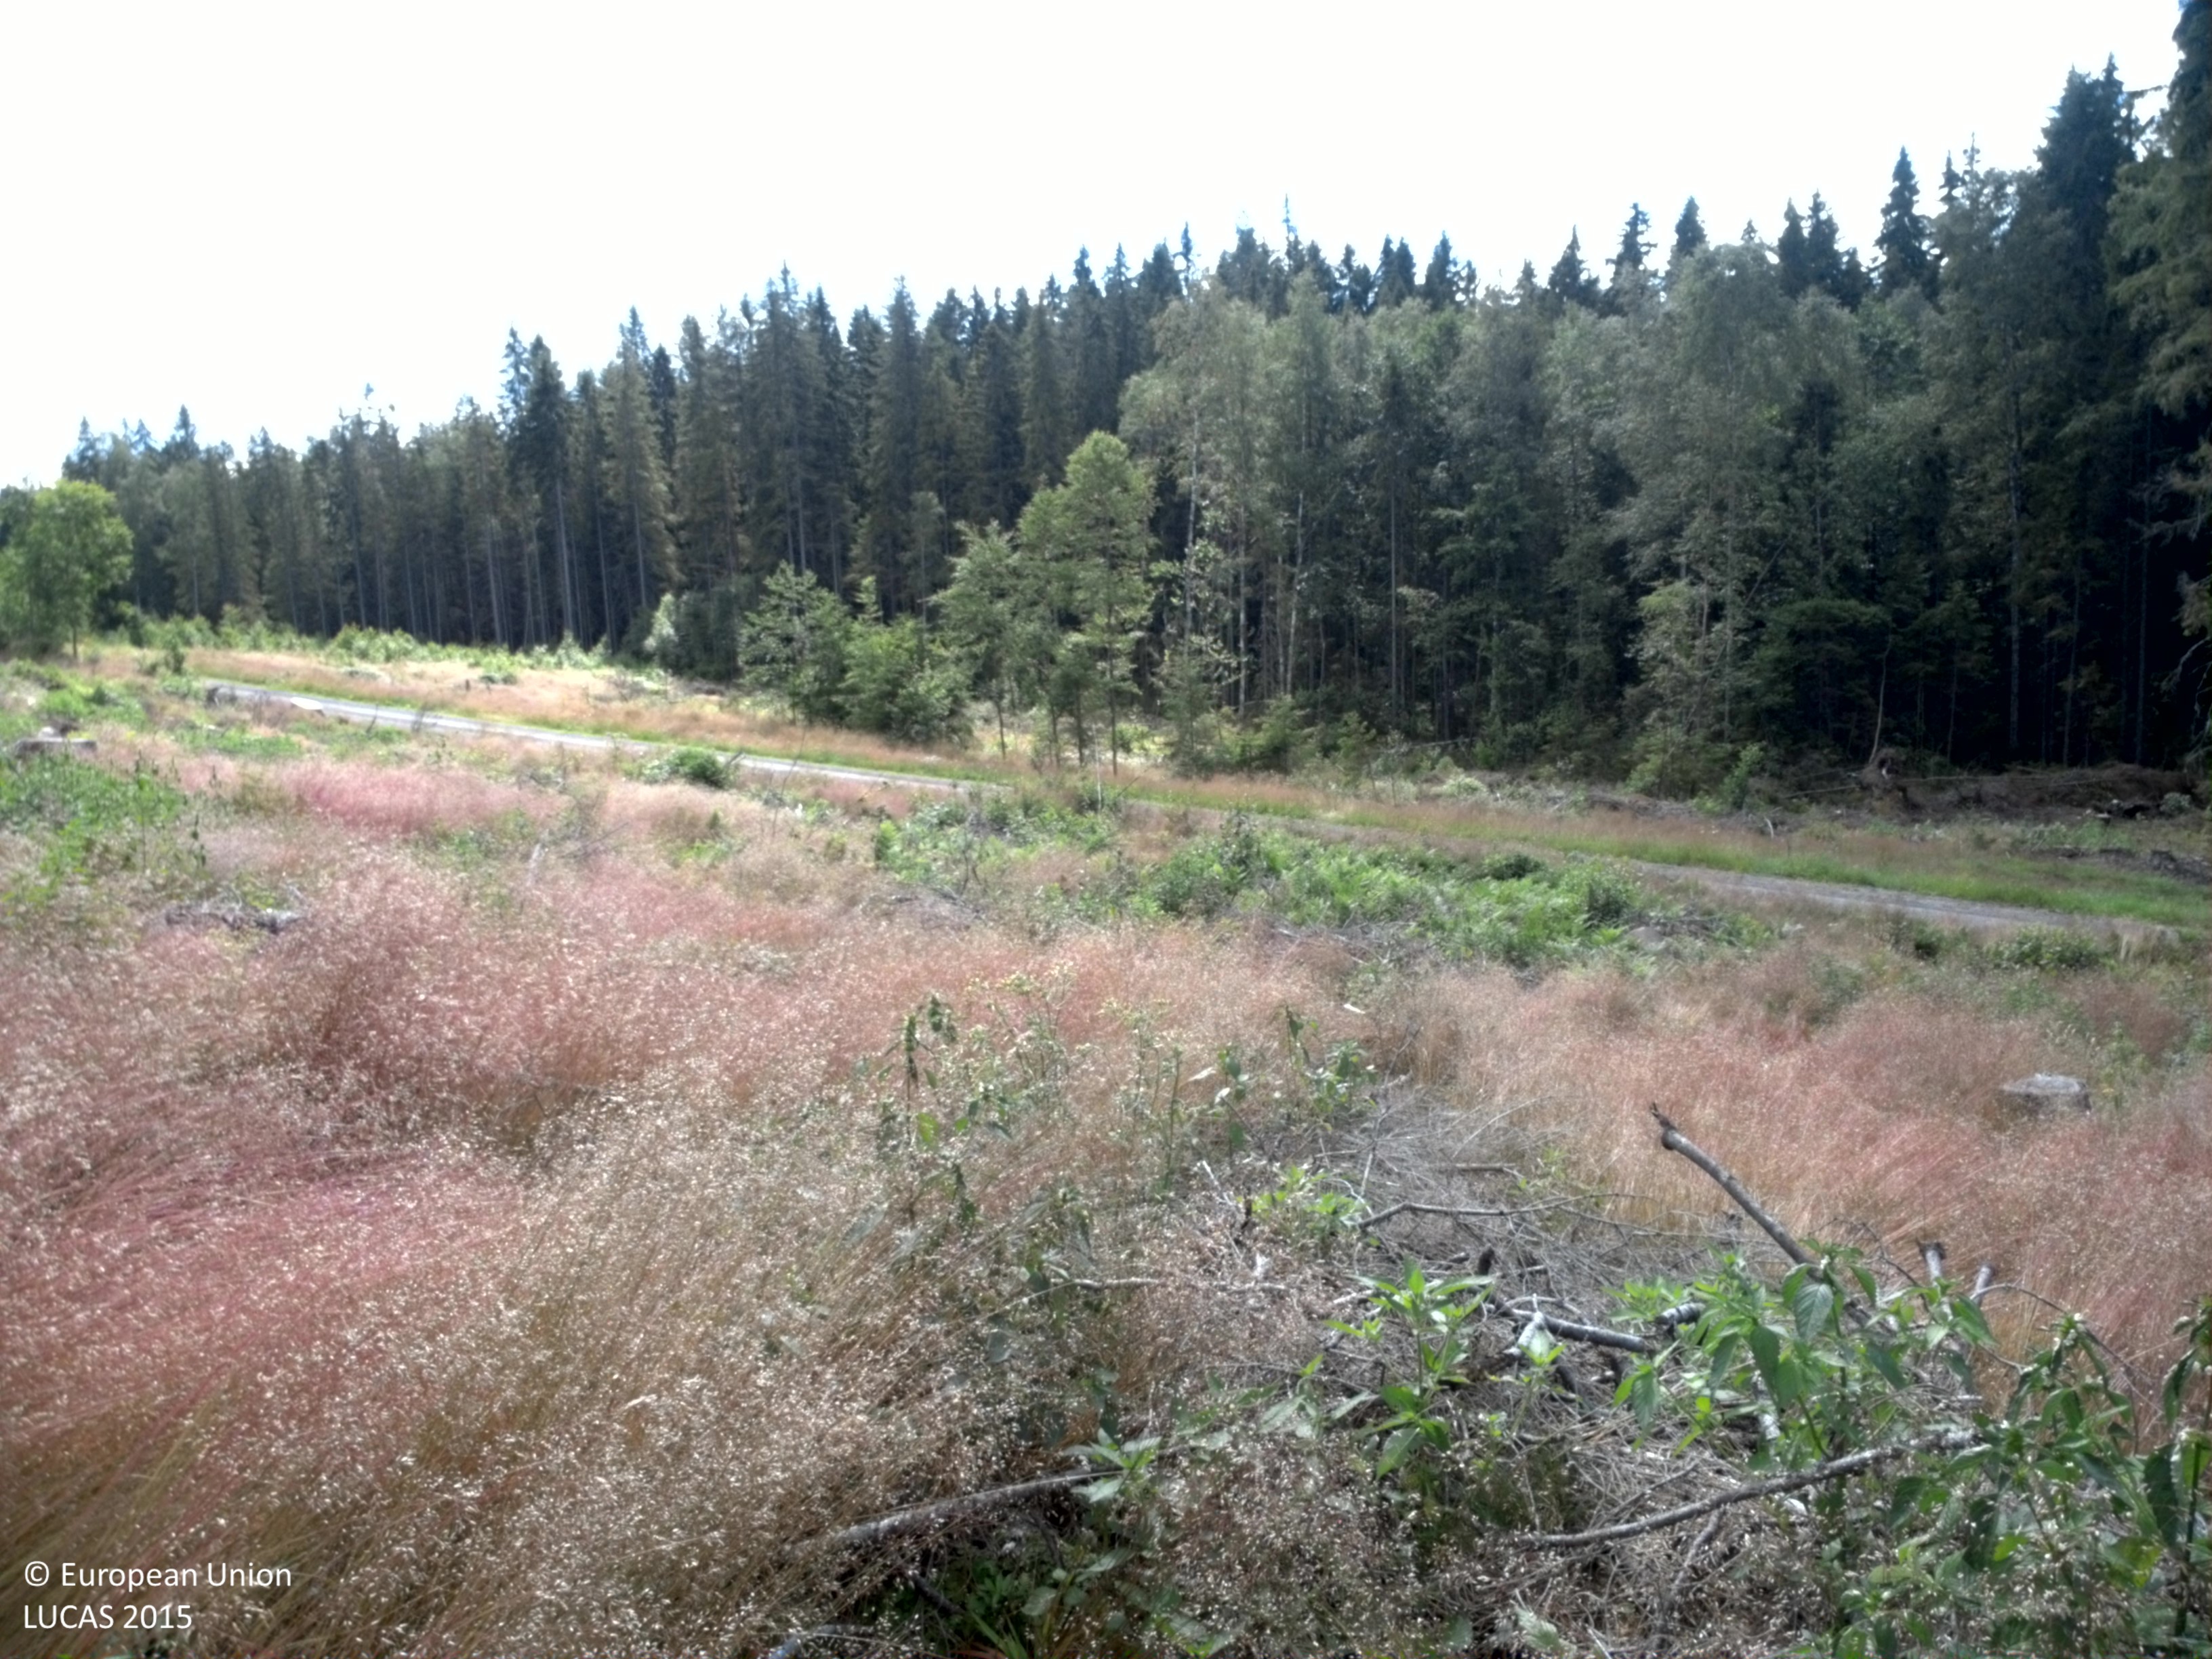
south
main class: Shrubland
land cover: Shrubland with sparse tree cover
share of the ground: 25 - 50 %
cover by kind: herbaceous plants 40 %, shrubs 35 %, consolidated bare surface 10 %, coniferous forest trees 5 %
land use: Forestry
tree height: < 5 m
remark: Clear cut
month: July
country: SE
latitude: 60.0010
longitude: 13.1652
